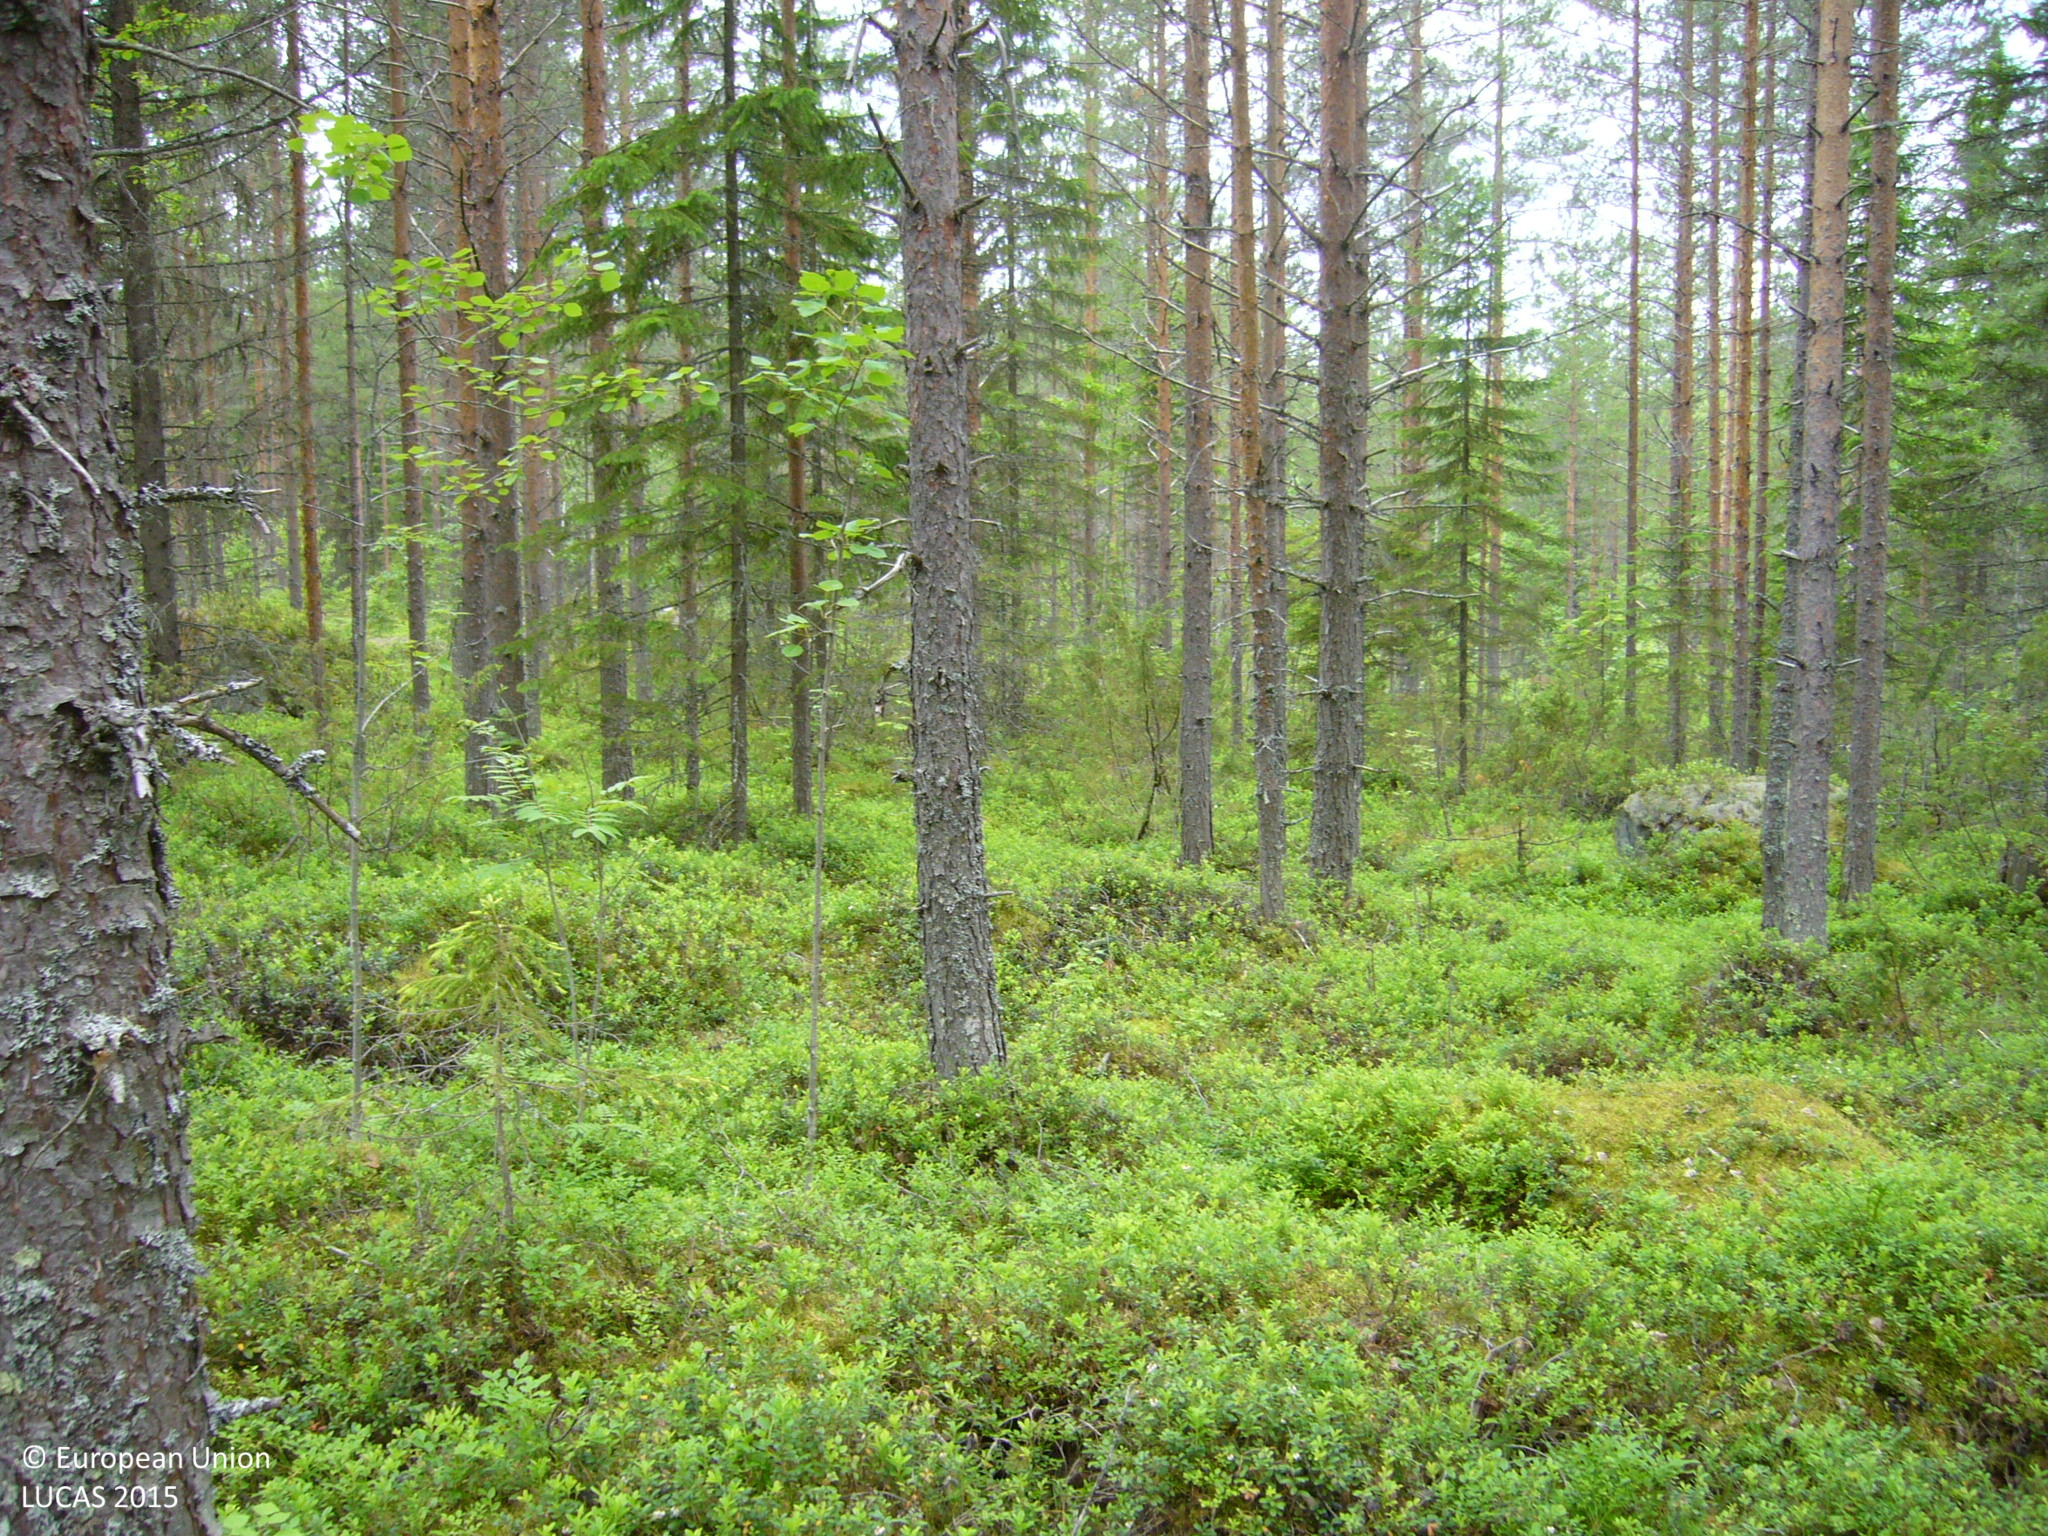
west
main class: Woodland
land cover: Pine dominated coniferous woodland
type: boreal forest
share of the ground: 50 - 75 %
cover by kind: coniferous forest trees 60 %, shrubs 40 %
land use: Forestry
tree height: > 5 m
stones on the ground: 25 - 50 %
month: July
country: FI
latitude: 63.4266
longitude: 26.2090
